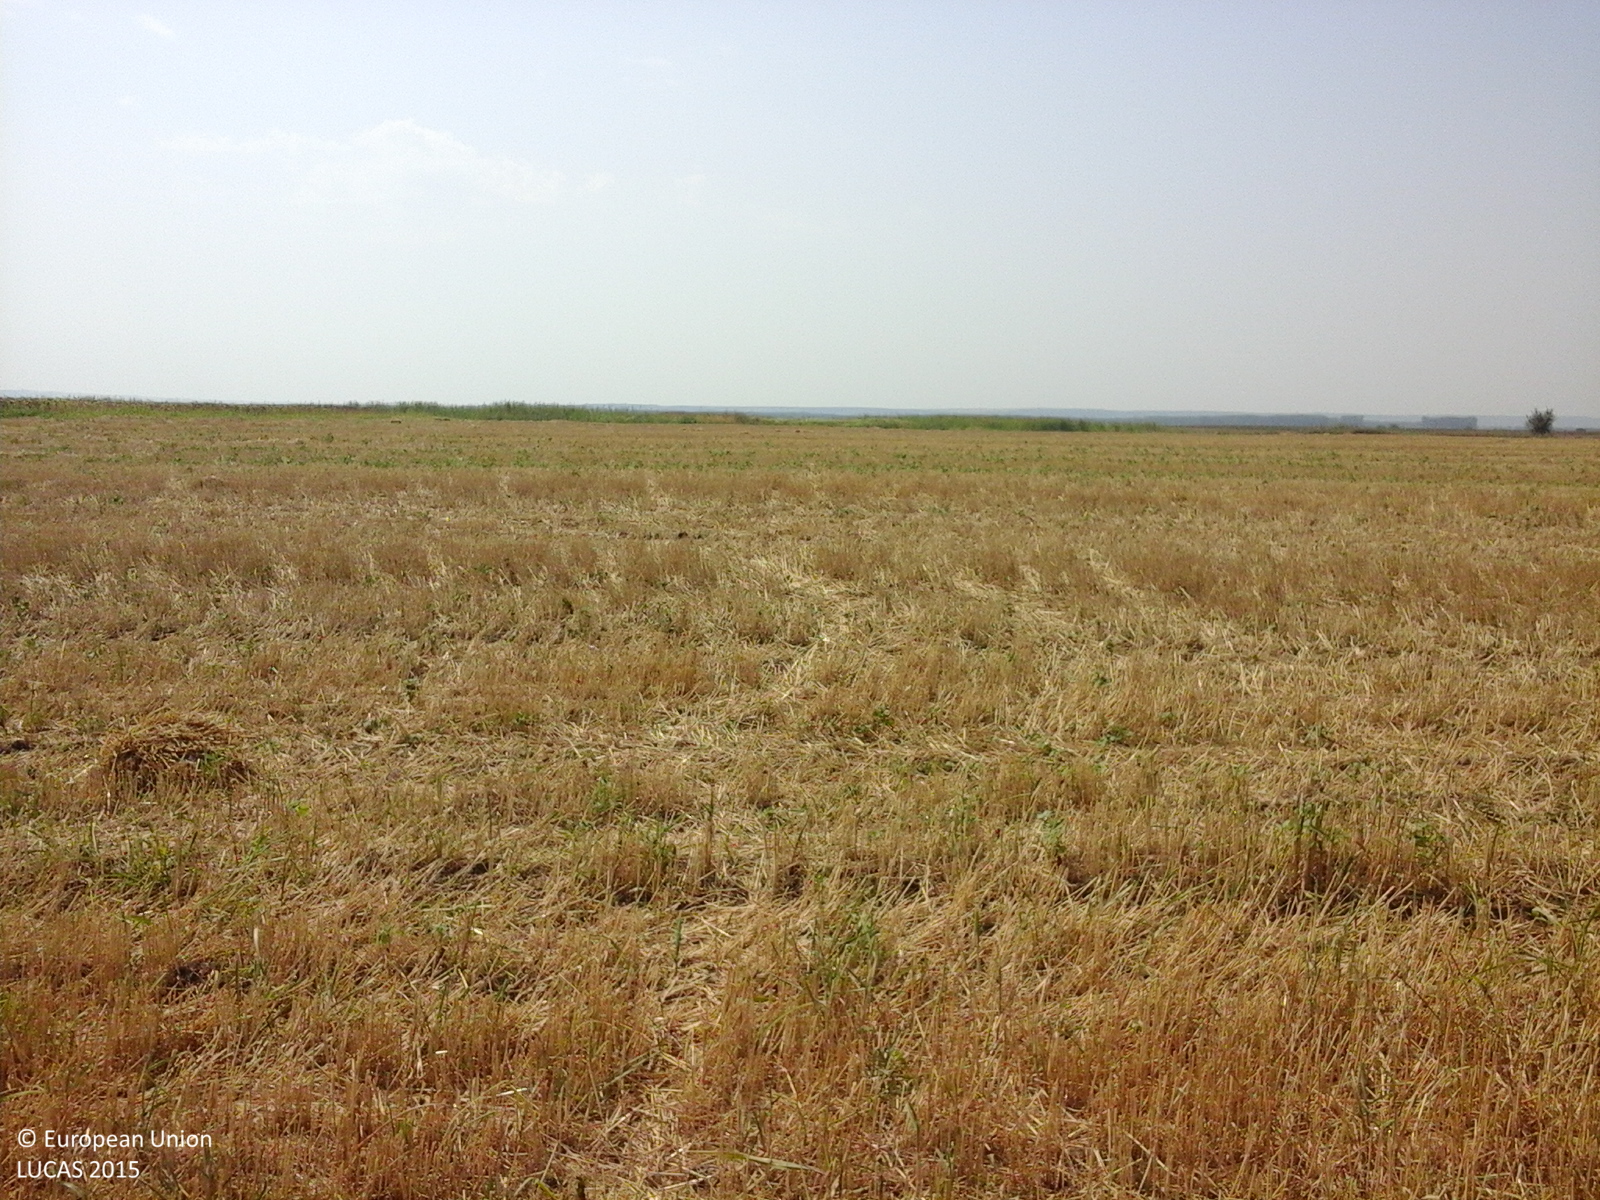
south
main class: Cropland
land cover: Common wheat
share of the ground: > 75 %
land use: Agriculture (excluding fallow land and kitchen gardens)
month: August
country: RO
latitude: 43.8833
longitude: 23.2247
